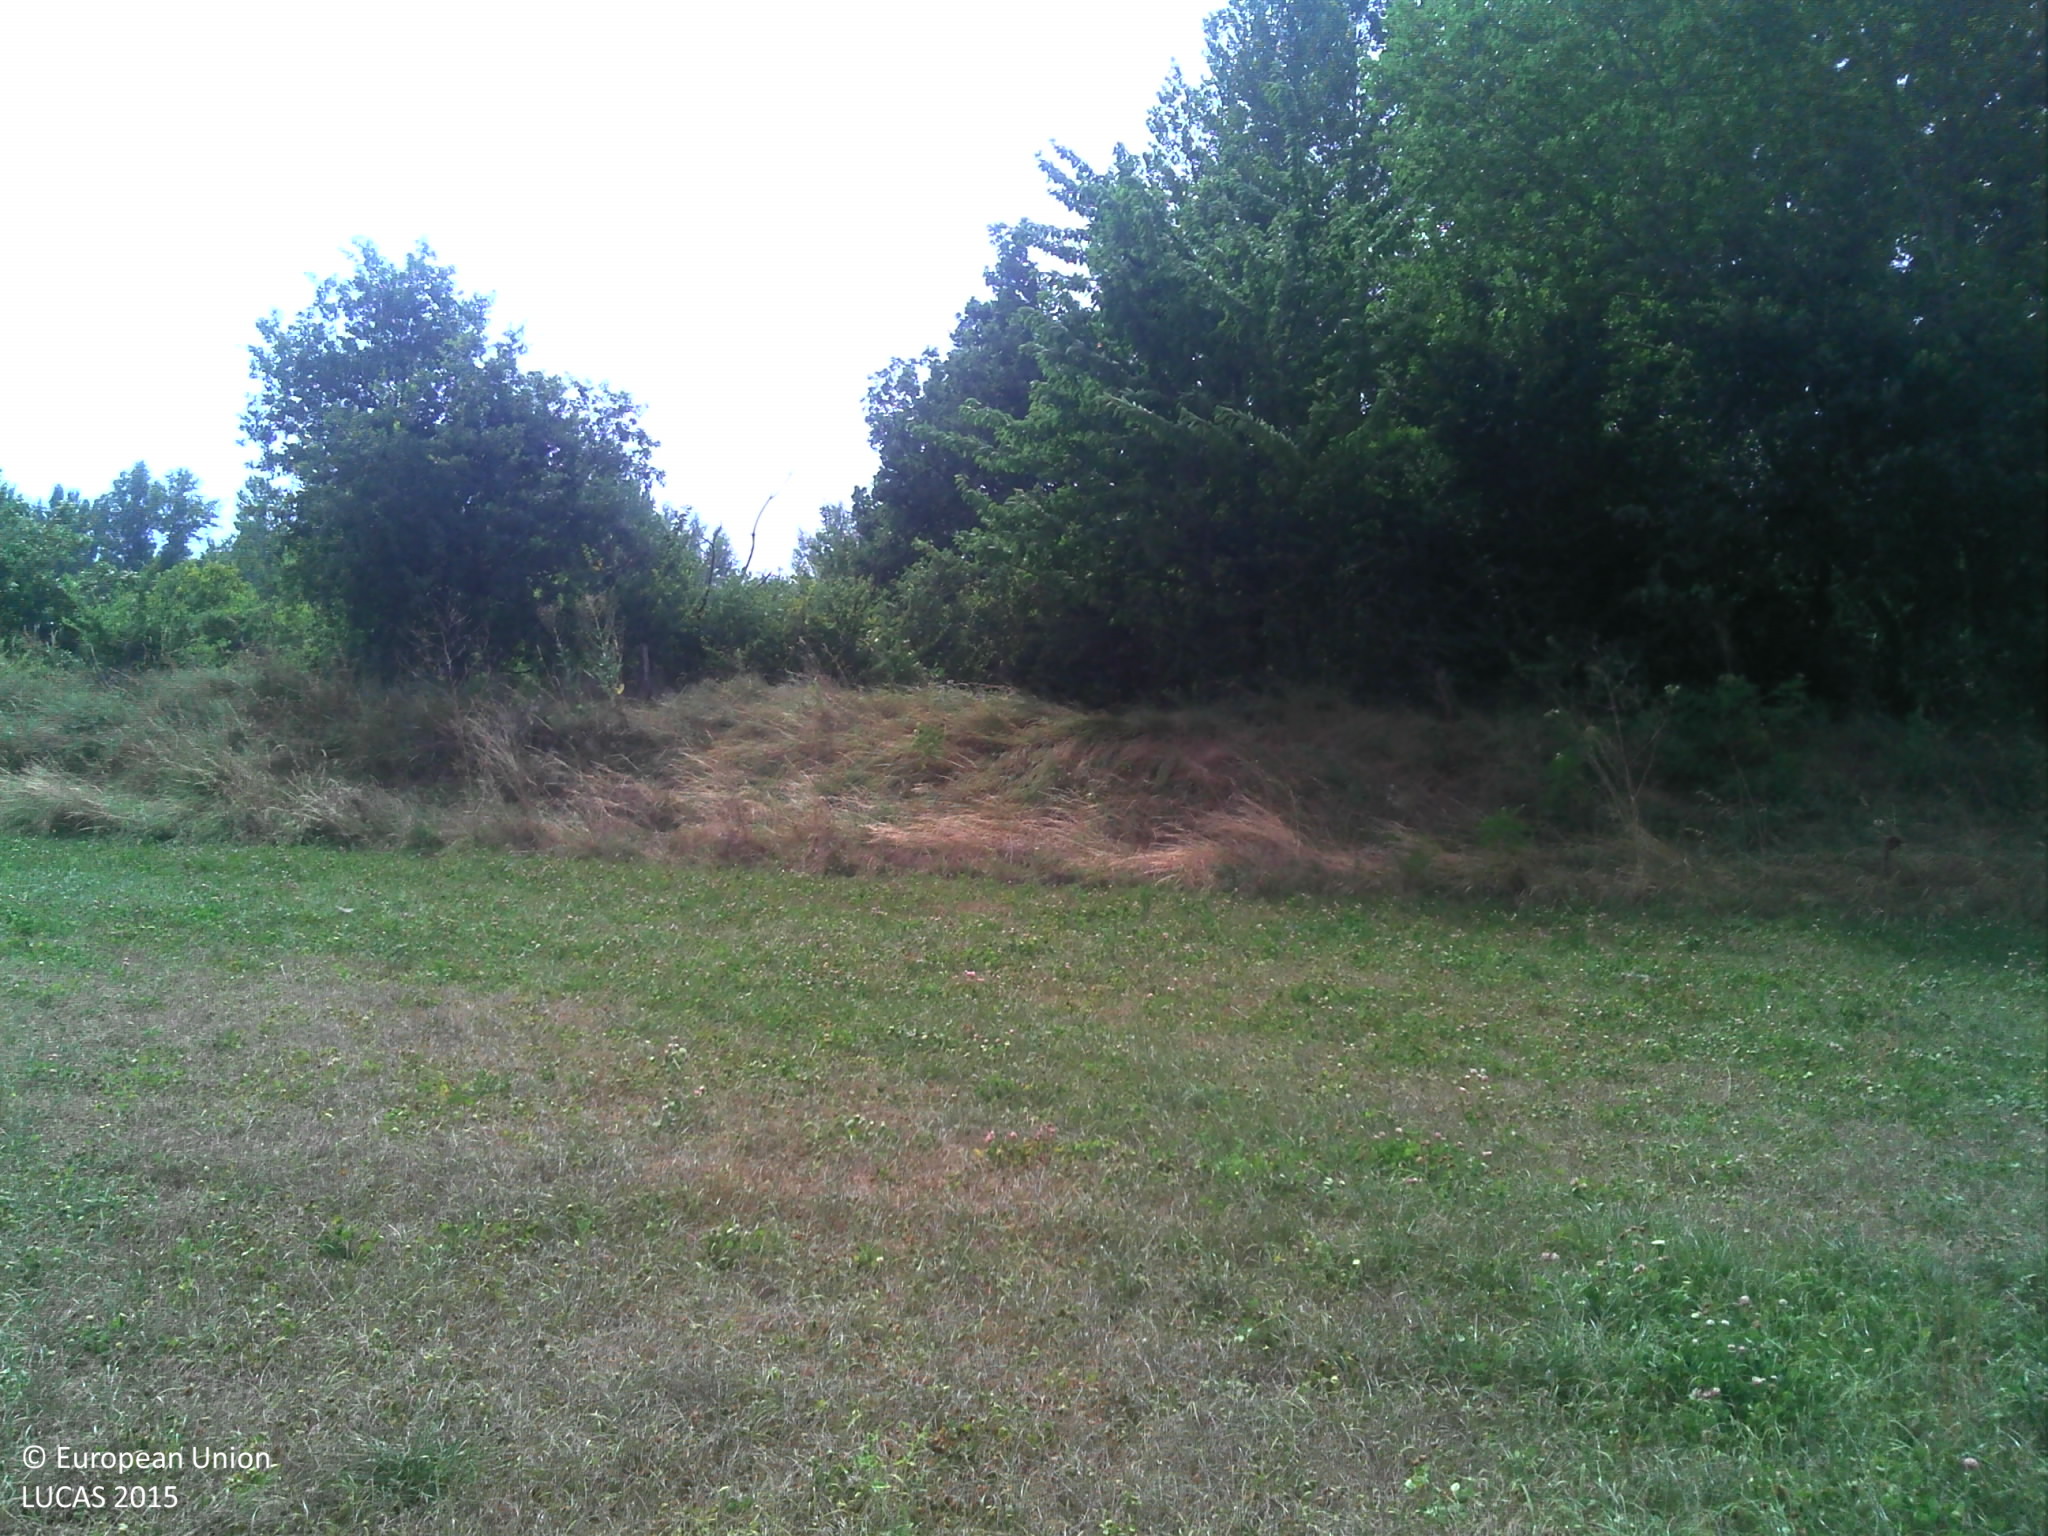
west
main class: Grassland
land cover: Grassland without tree/shrub cover
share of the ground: > 75 %
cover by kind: herbaceous plants 100 %
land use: Agriculture (excluding fallow land and kitchen gardens)
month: July
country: FR
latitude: 43.2754
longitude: 1.0693
